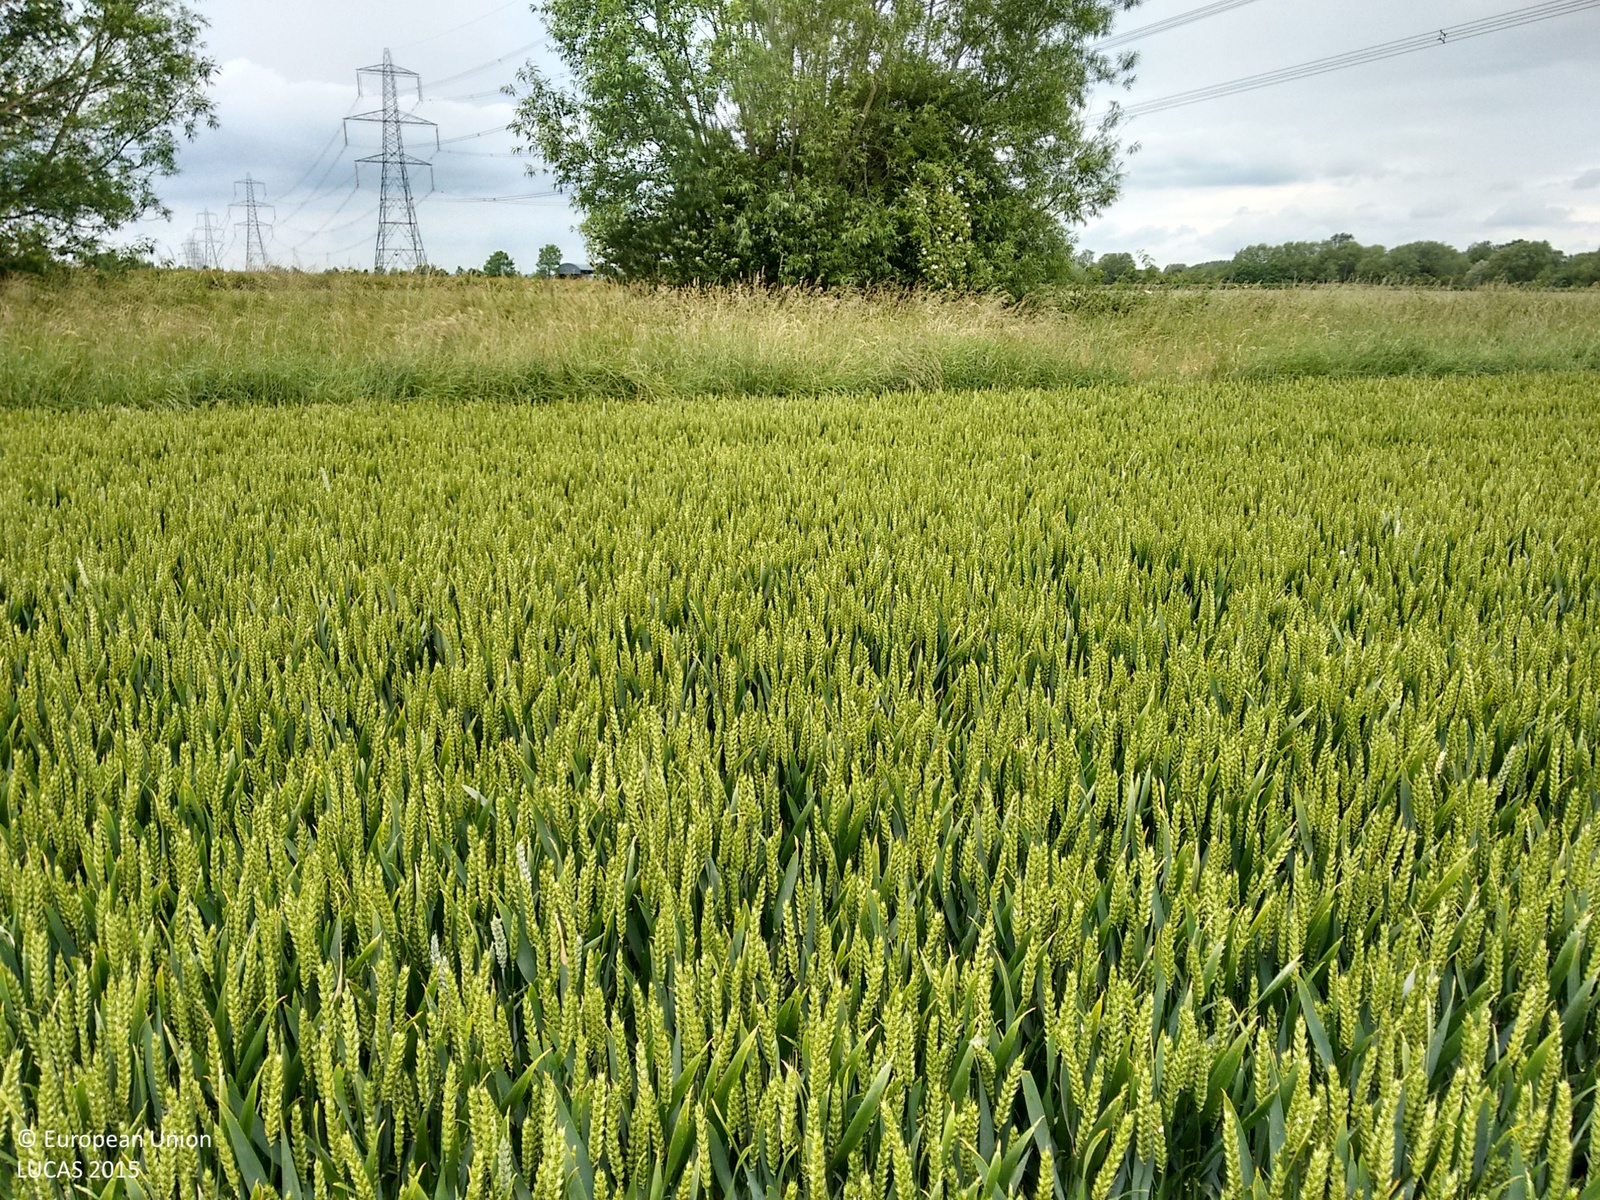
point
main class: Cropland
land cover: Common wheat
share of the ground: > 75 %
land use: Agriculture (excluding fallow land and kitchen gardens)
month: June
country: GB
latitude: 51.6963
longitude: -1.6126
